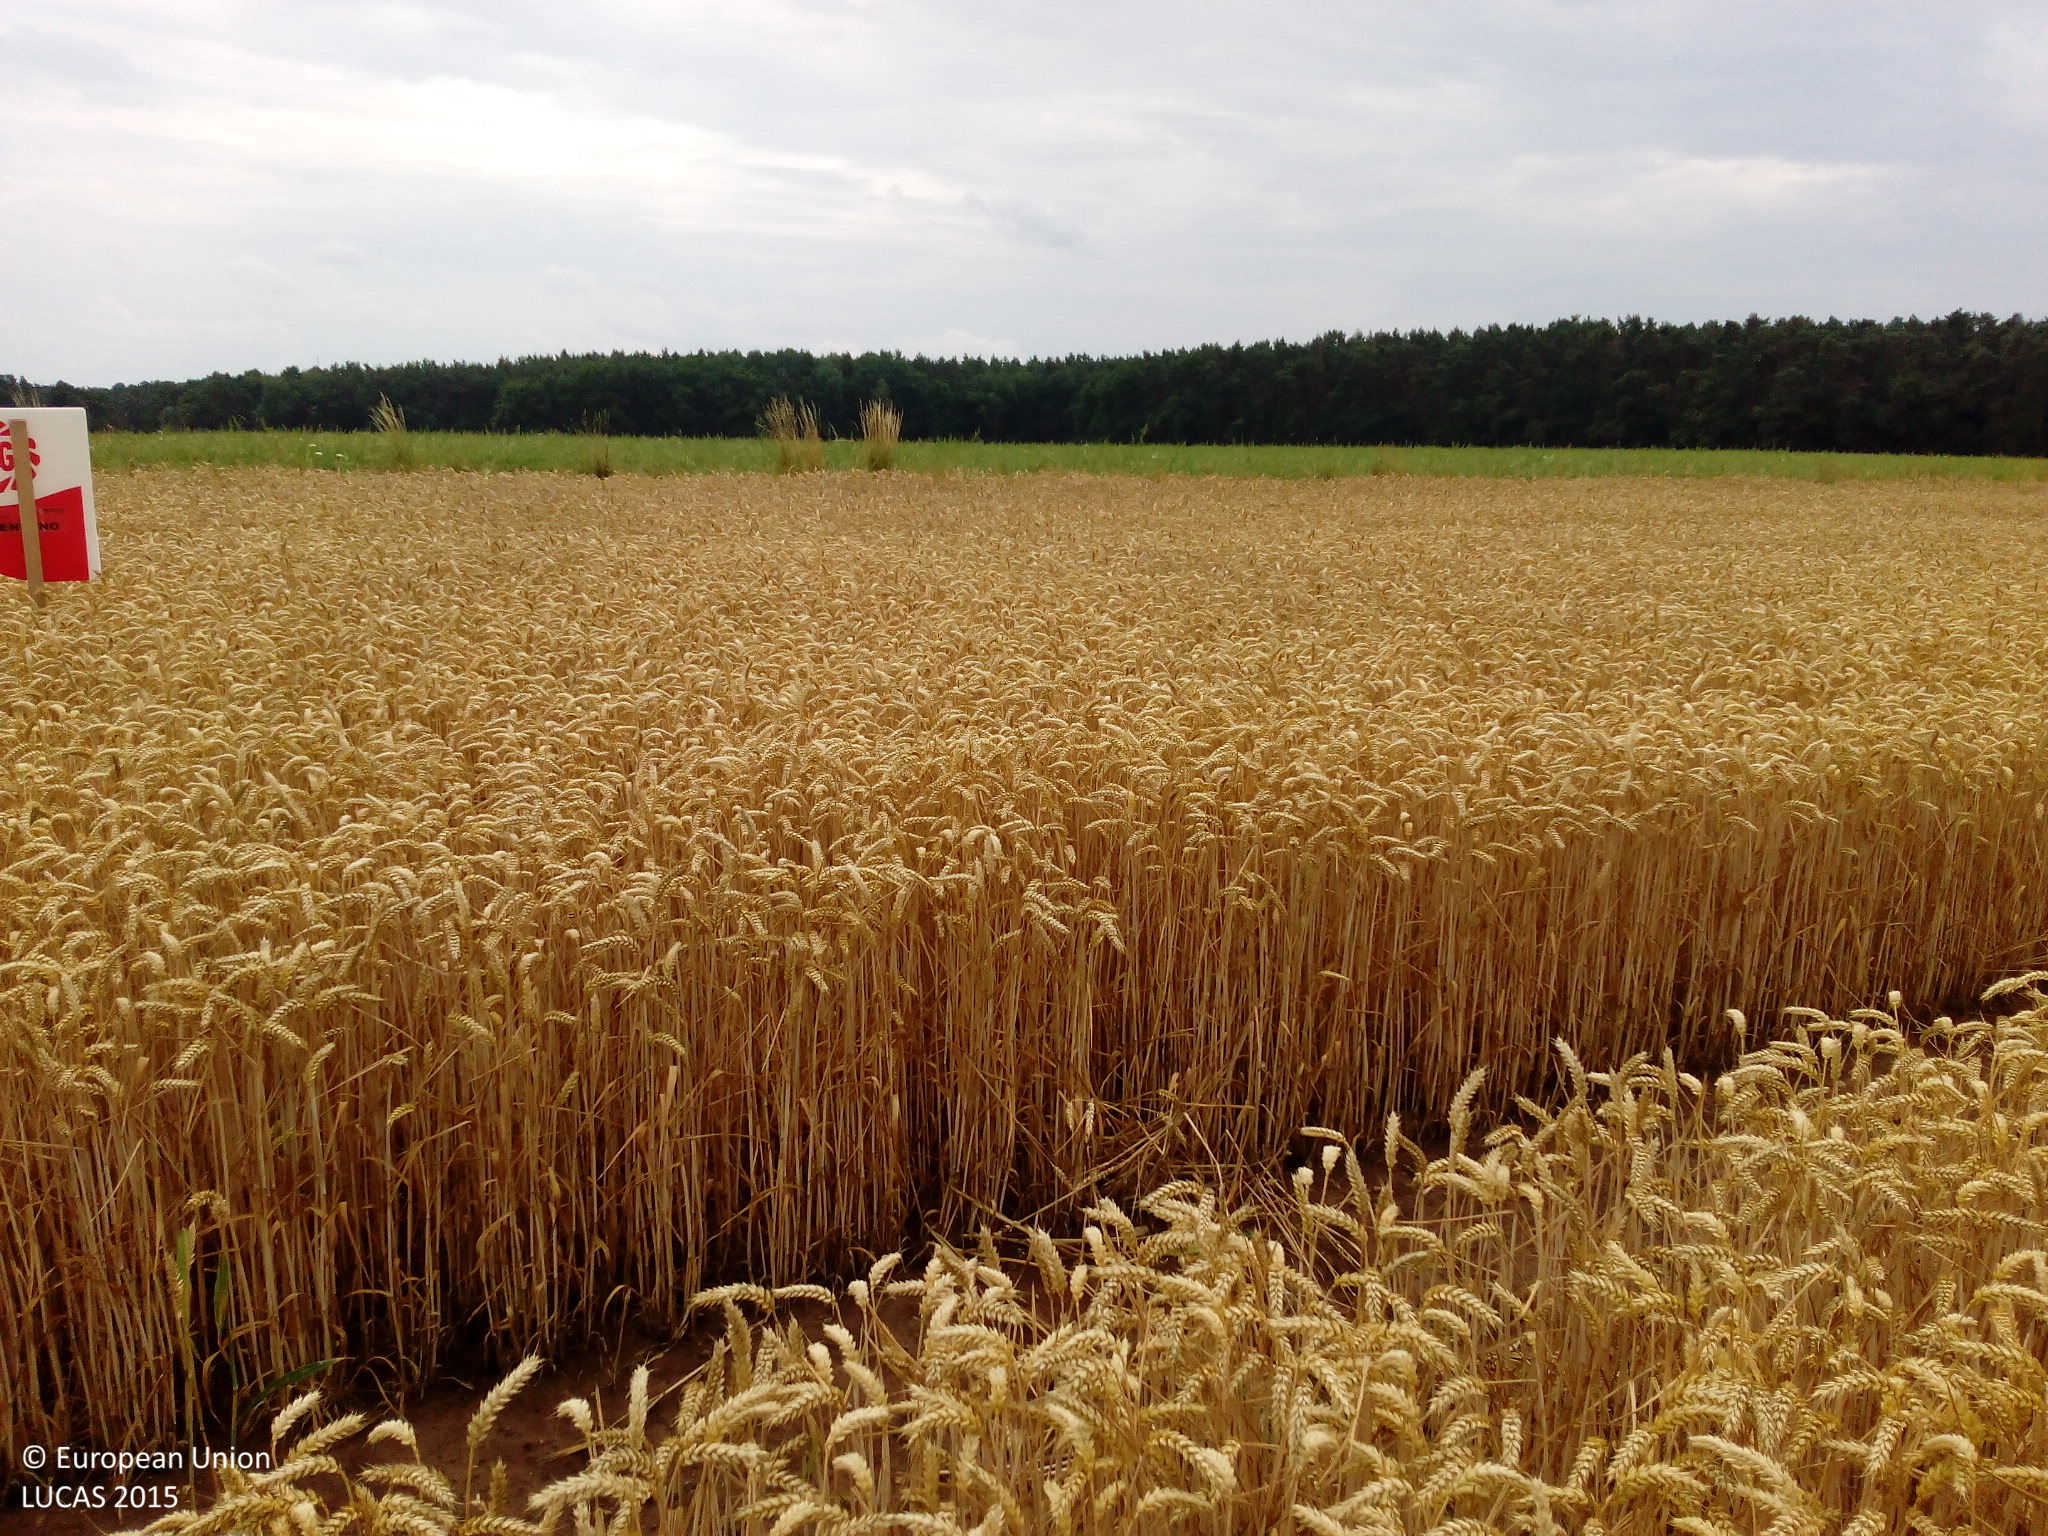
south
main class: Cropland
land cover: Common wheat
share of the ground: > 75 %
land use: Agriculture (excluding fallow land and kitchen gardens)
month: July
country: DE
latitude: 49.5512
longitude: 10.8981
